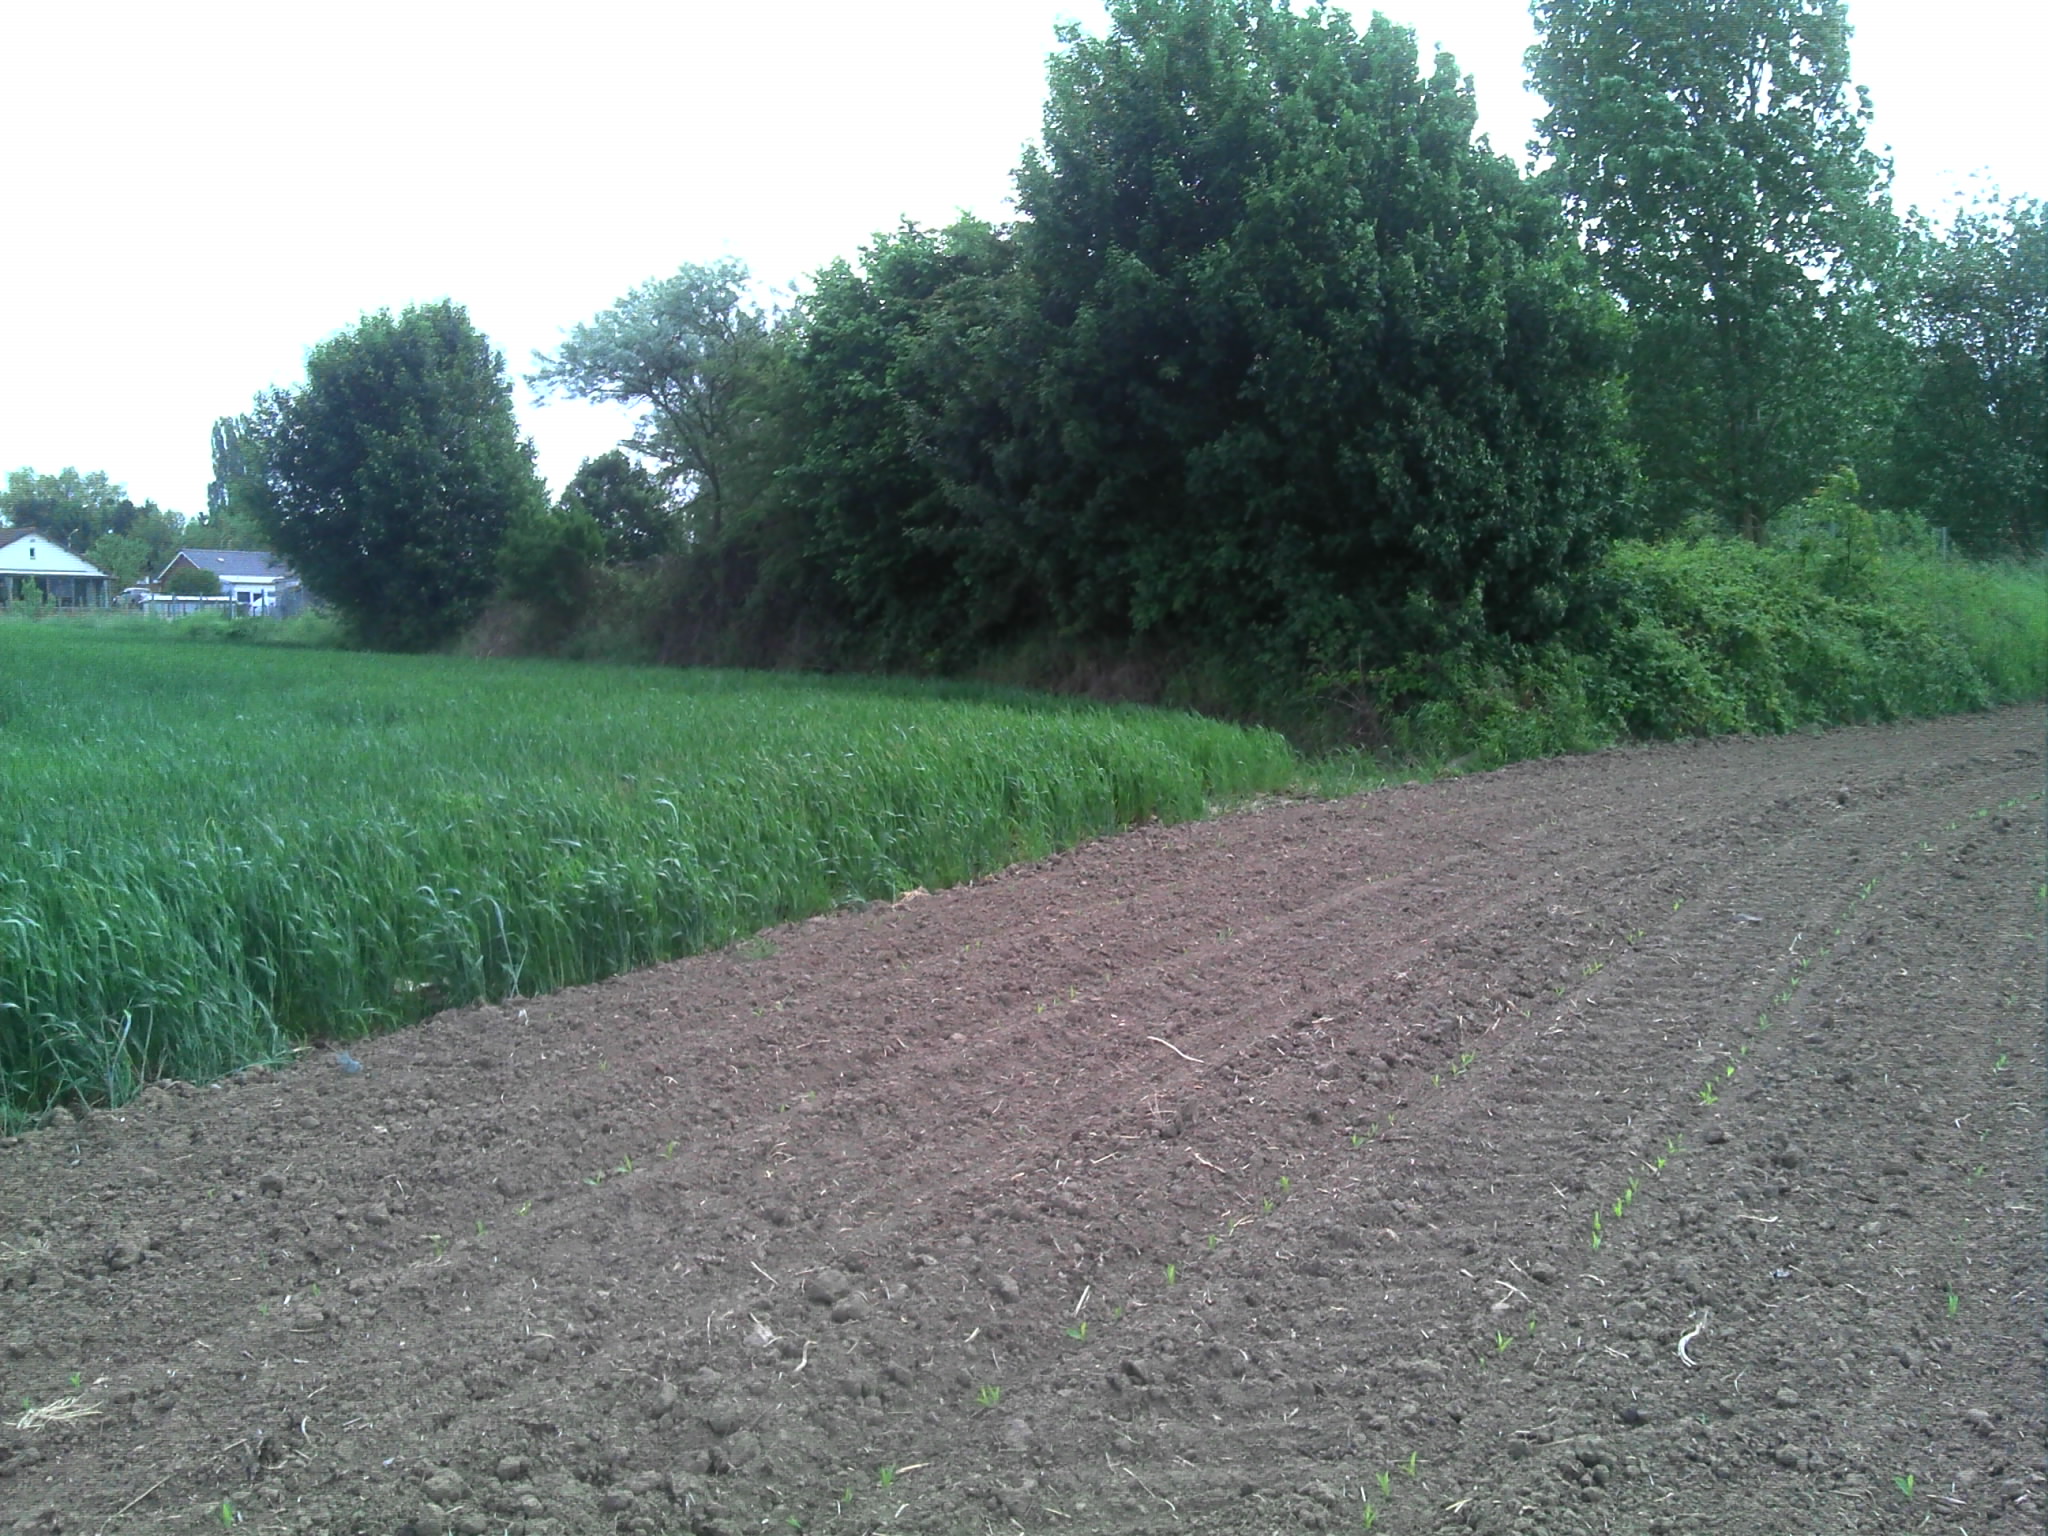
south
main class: Cropland
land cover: Maize
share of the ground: < 10 %
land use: Agriculture (excluding fallow land and kitchen gardens)
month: June
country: BE
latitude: 50.4721
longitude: 4.6279
